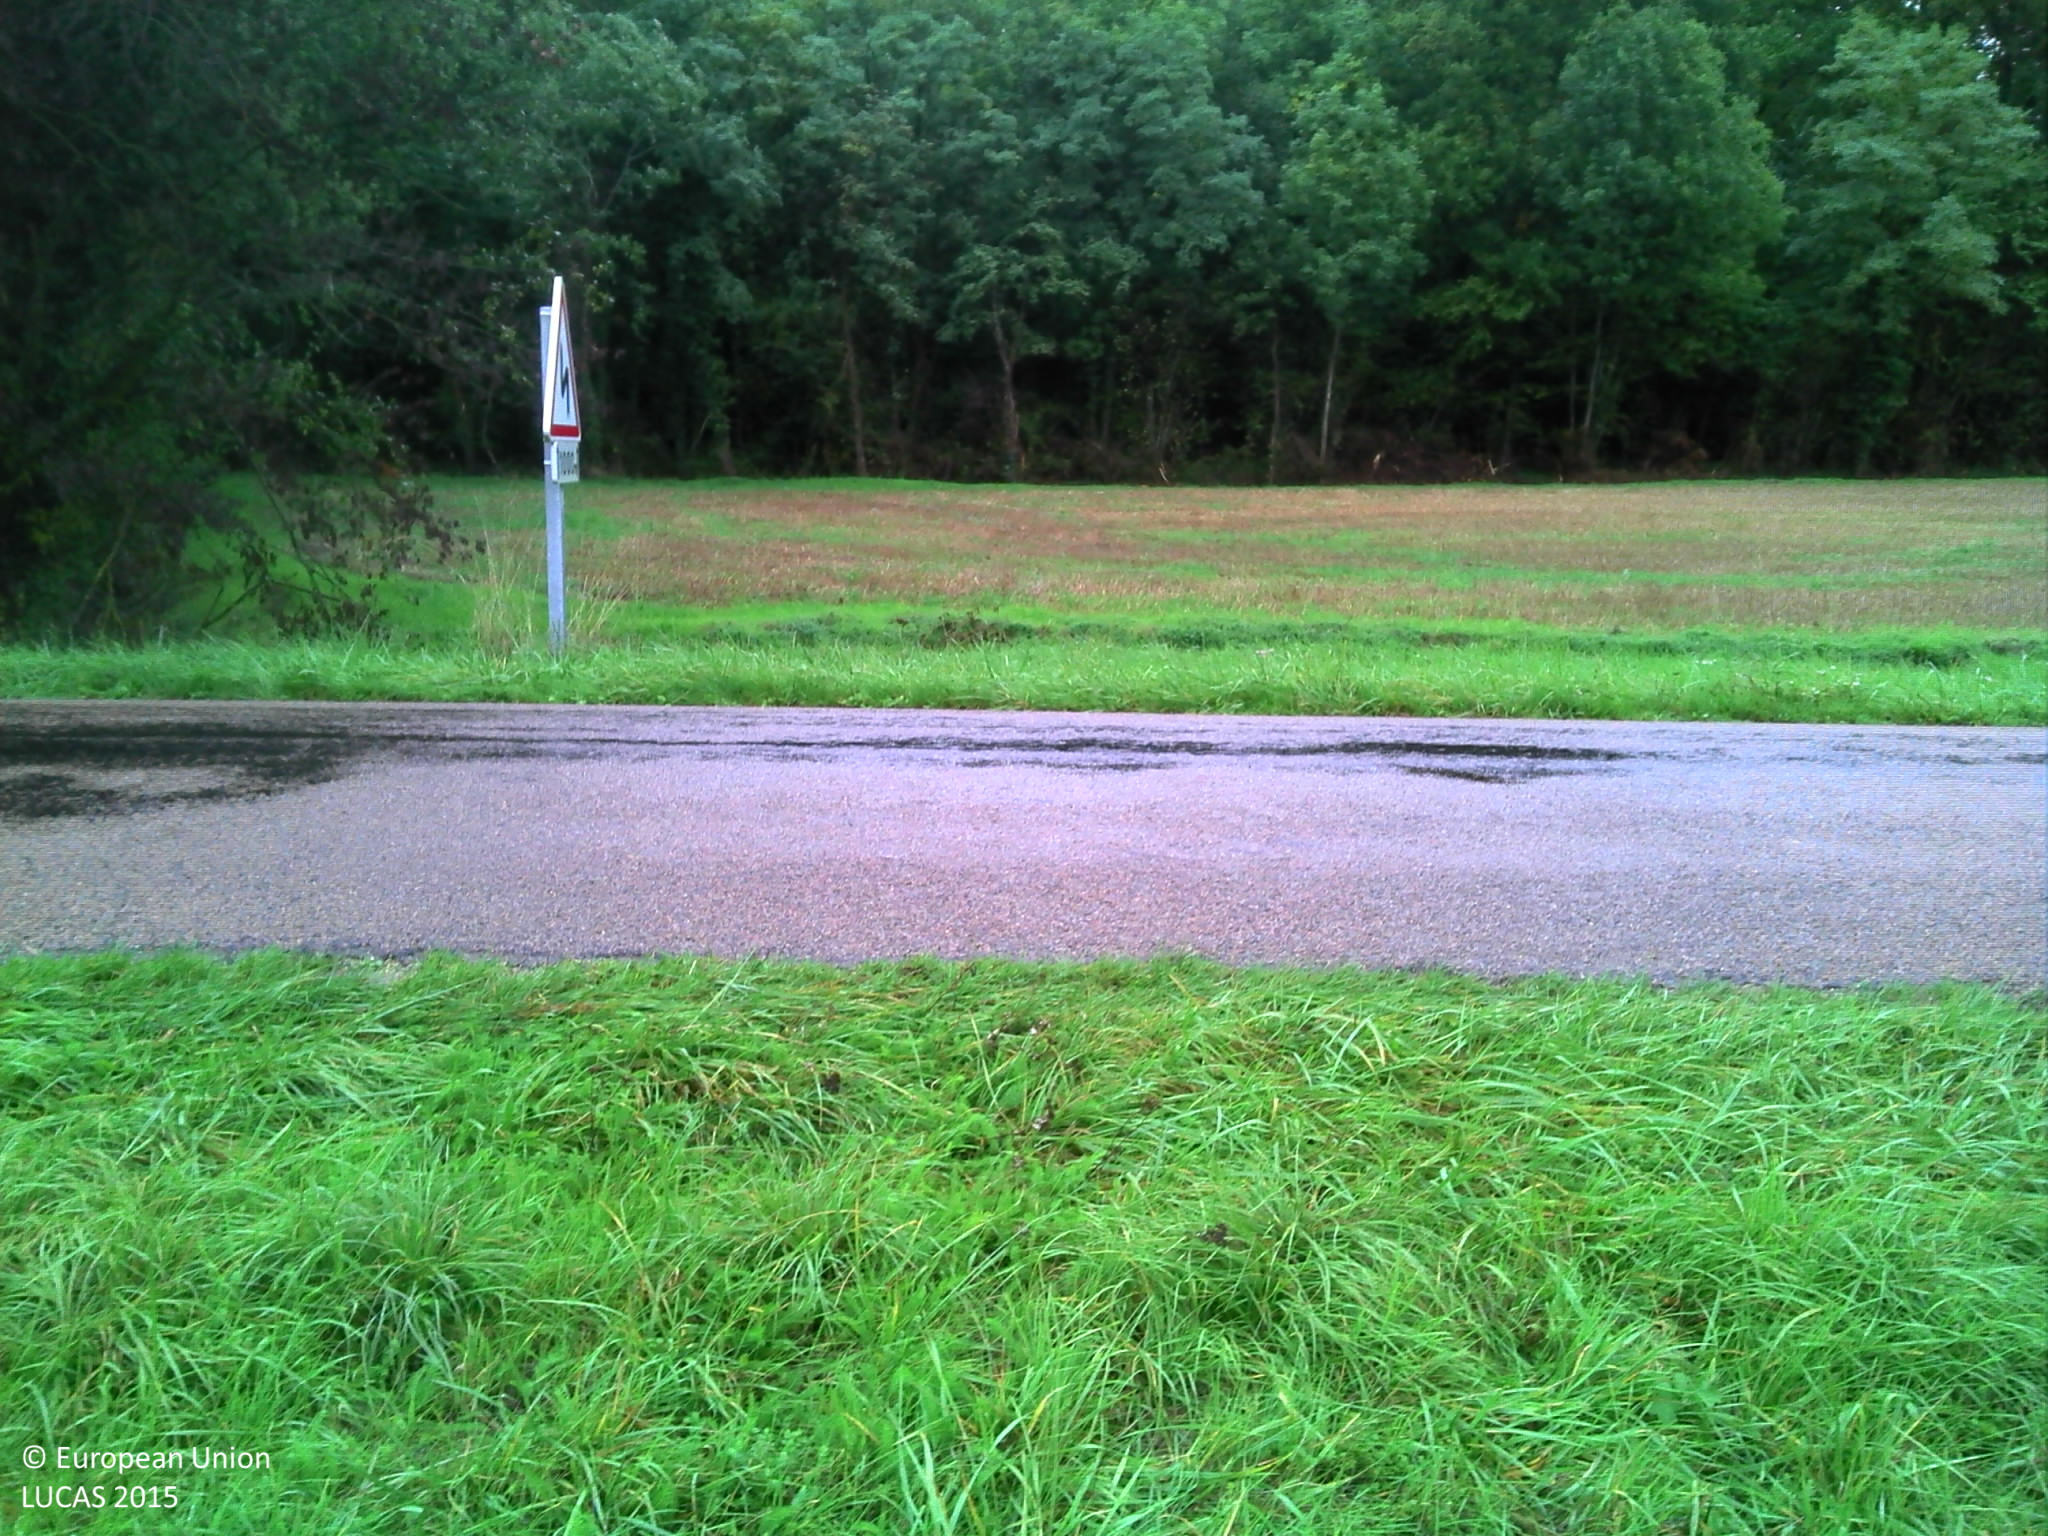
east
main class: Cropland
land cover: Maize
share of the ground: > 75 %
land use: Agriculture (excluding fallow land and kitchen gardens)
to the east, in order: Maize; Ditches and canals; Grass margins; Paved roads, cycling and walking lanes; Grass margins; Ditches and canals; Grass margins; Common wheat; Grass margins; Broadleaved woodland
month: October
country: FR
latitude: 48.2329
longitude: 4.1942
